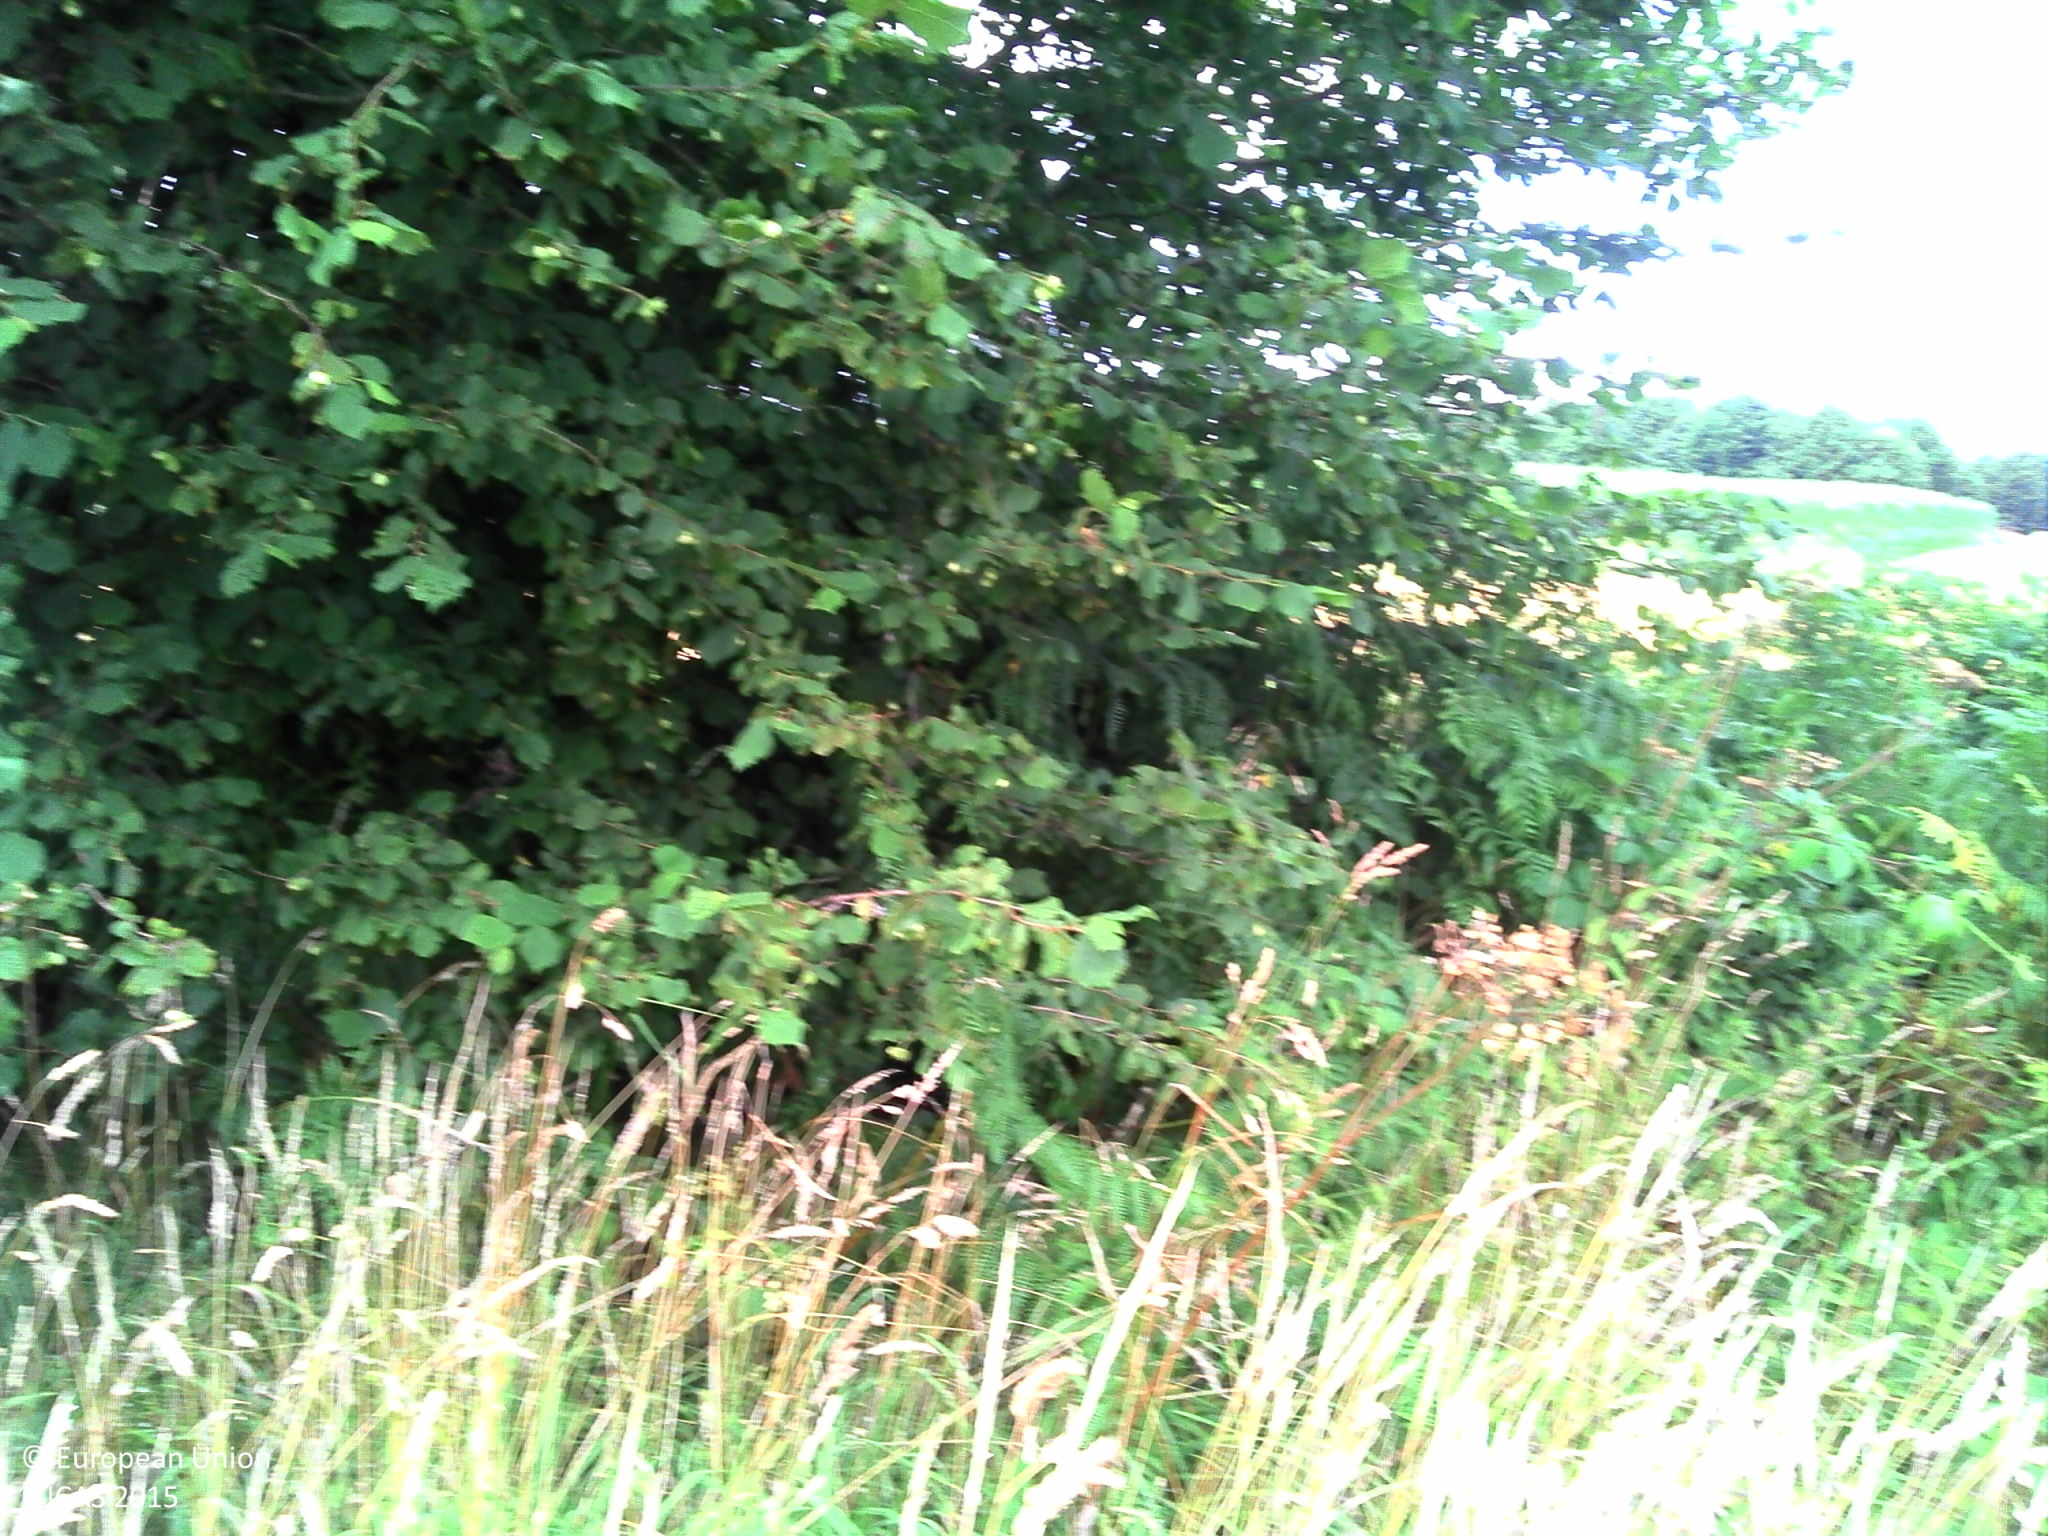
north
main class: Cropland
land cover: Maize
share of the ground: > 75 %
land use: Agriculture (excluding fallow land and kitchen gardens)
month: July
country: FR
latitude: 48.0828
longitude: -1.4145
